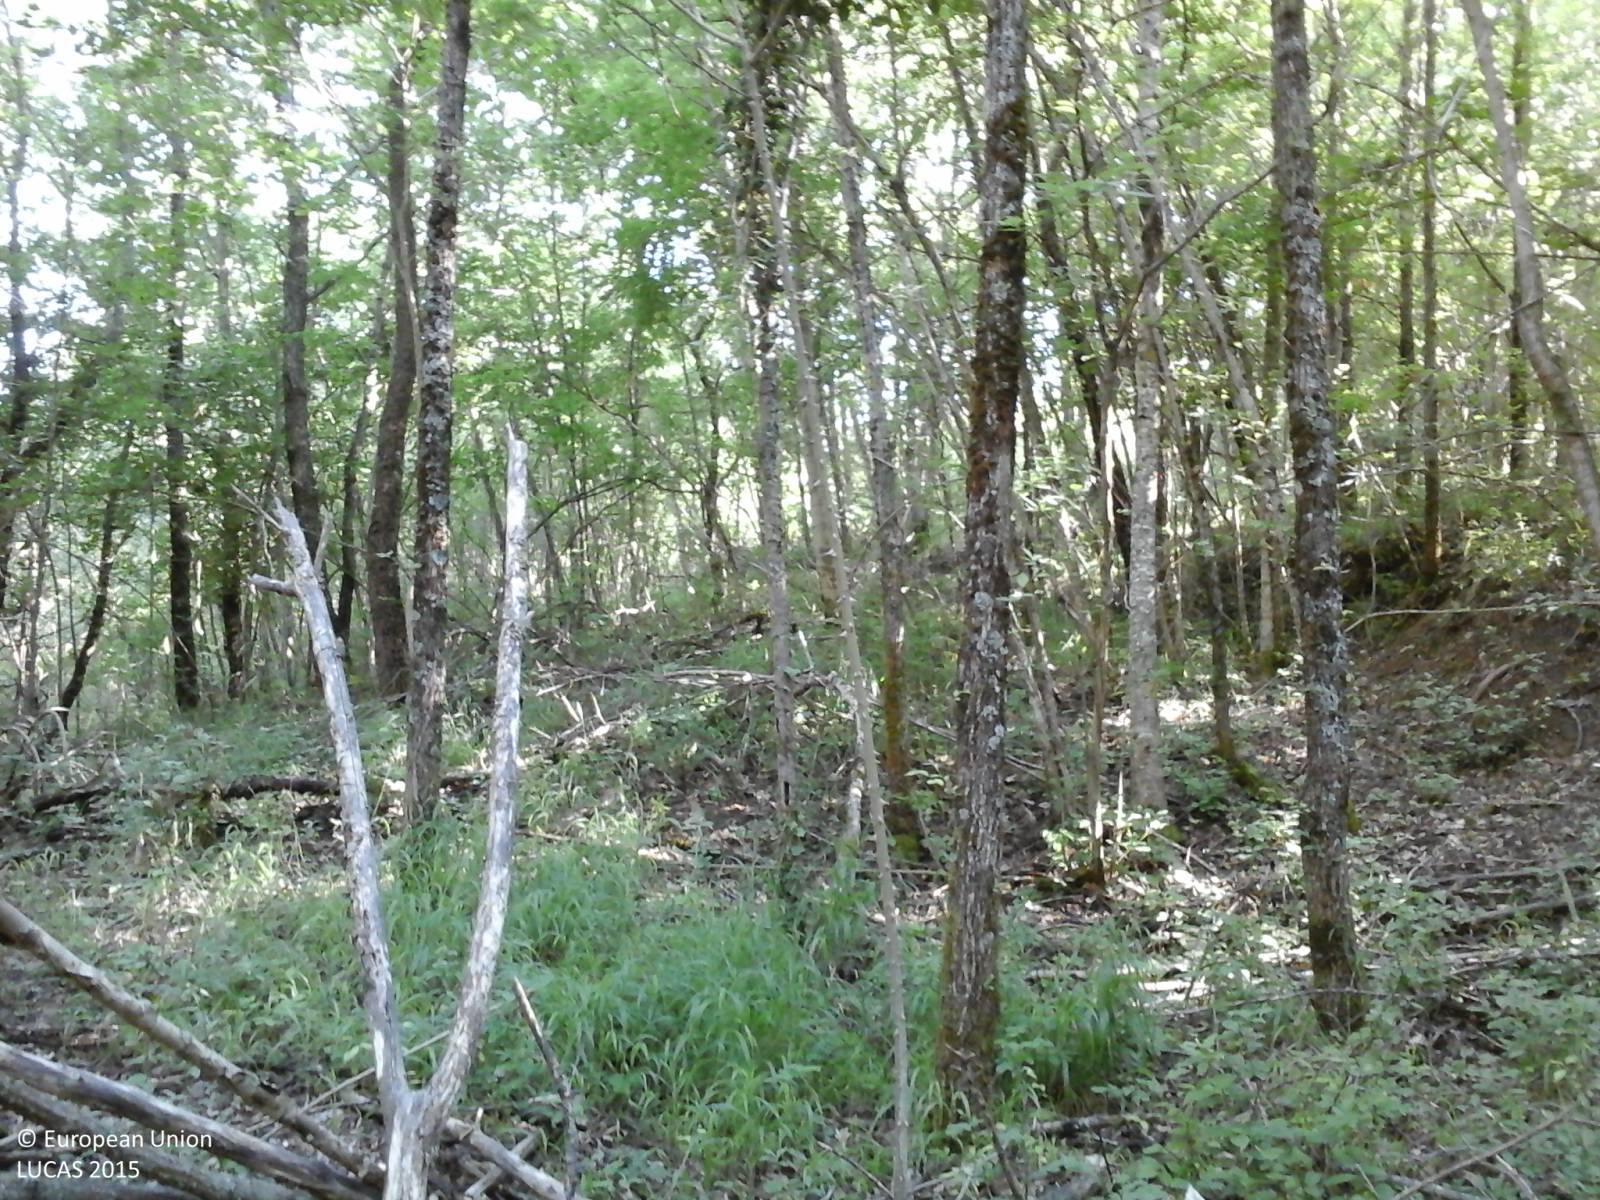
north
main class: Woodland
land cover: Broadleaved woodland
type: thermophilous deciduous forest
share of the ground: > 75 %
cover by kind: broadleaved forest trees 100 %
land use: Forestry
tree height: > 5 m
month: June
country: IT
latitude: 41.9855
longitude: 13.8133
